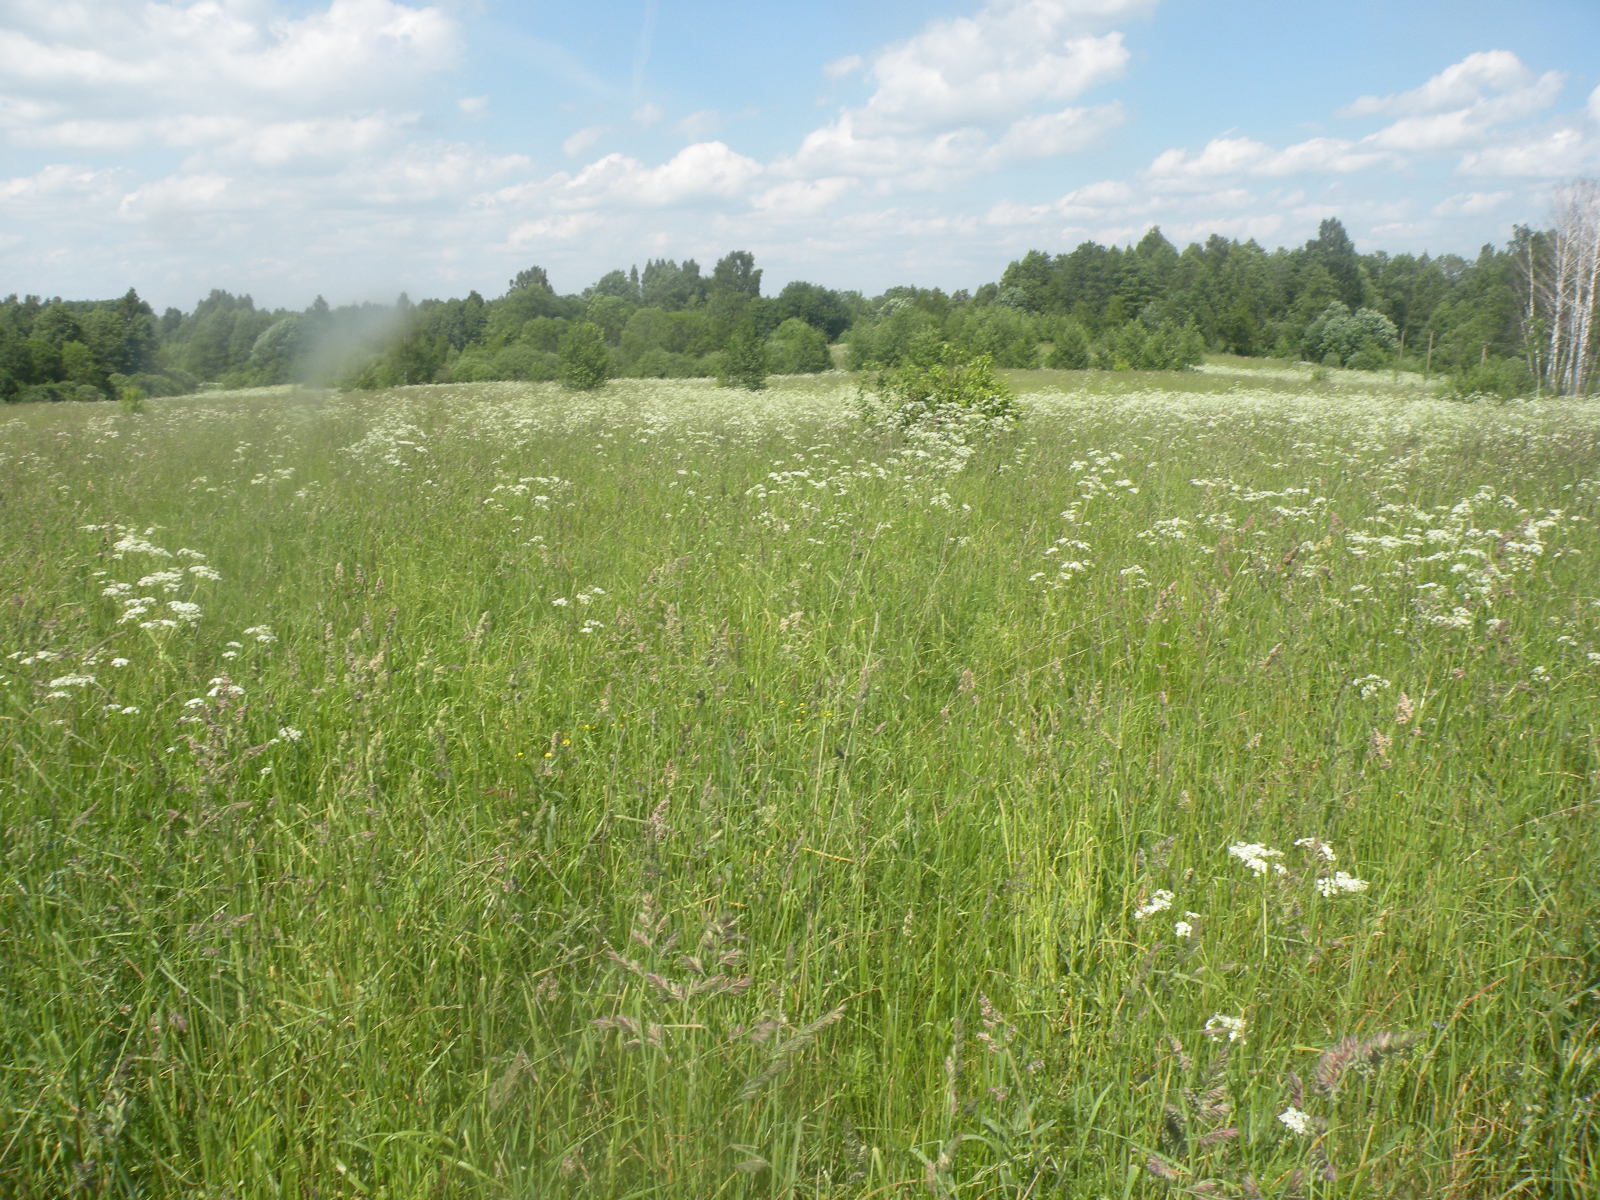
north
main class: Grassland
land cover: Spontaneously vegetated surfaces
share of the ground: > 75 %
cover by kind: herbaceous plants 100 %
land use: Semi-natural and natural areas not in use
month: June
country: LV
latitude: 56.1302
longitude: 26.8442
